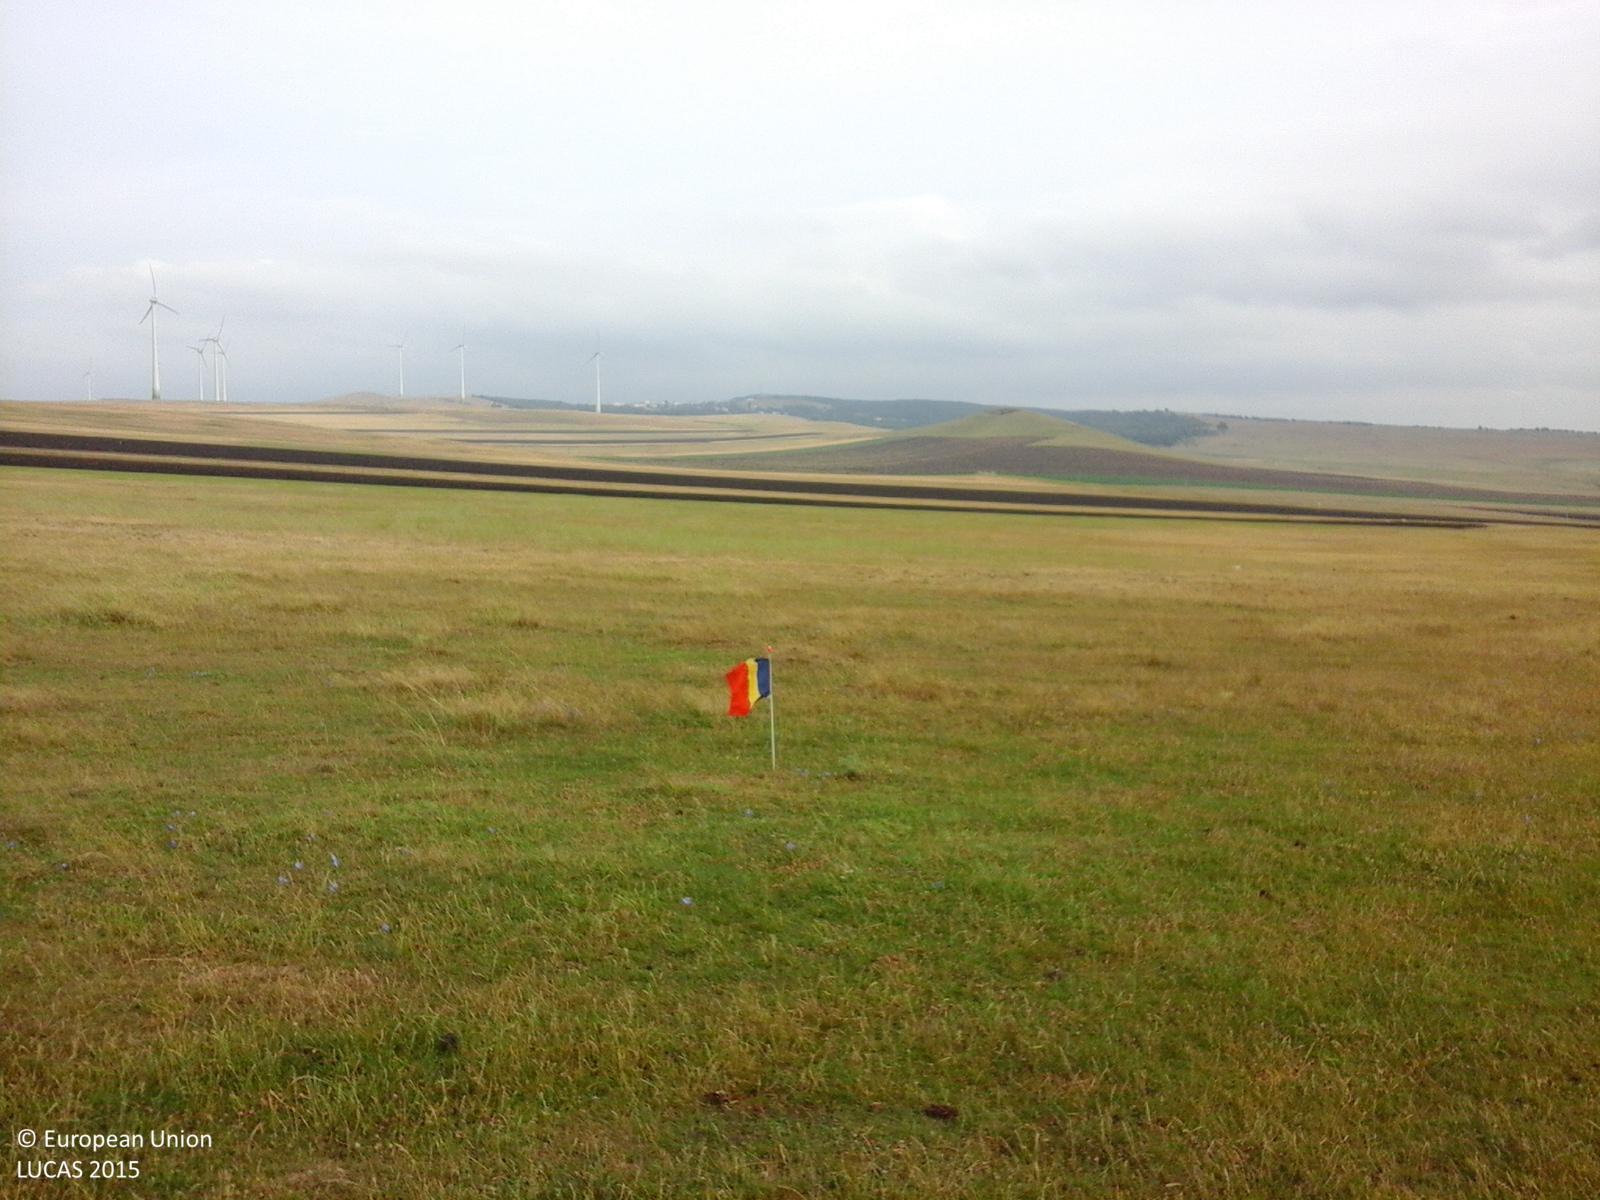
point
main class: Grassland
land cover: Grassland without tree/shrub cover
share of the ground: > 75 %
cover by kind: herbaceous plants 100 %
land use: Agriculture (excluding fallow land and kitchen gardens)
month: August
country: RO
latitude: 44.7588
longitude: 28.5859
